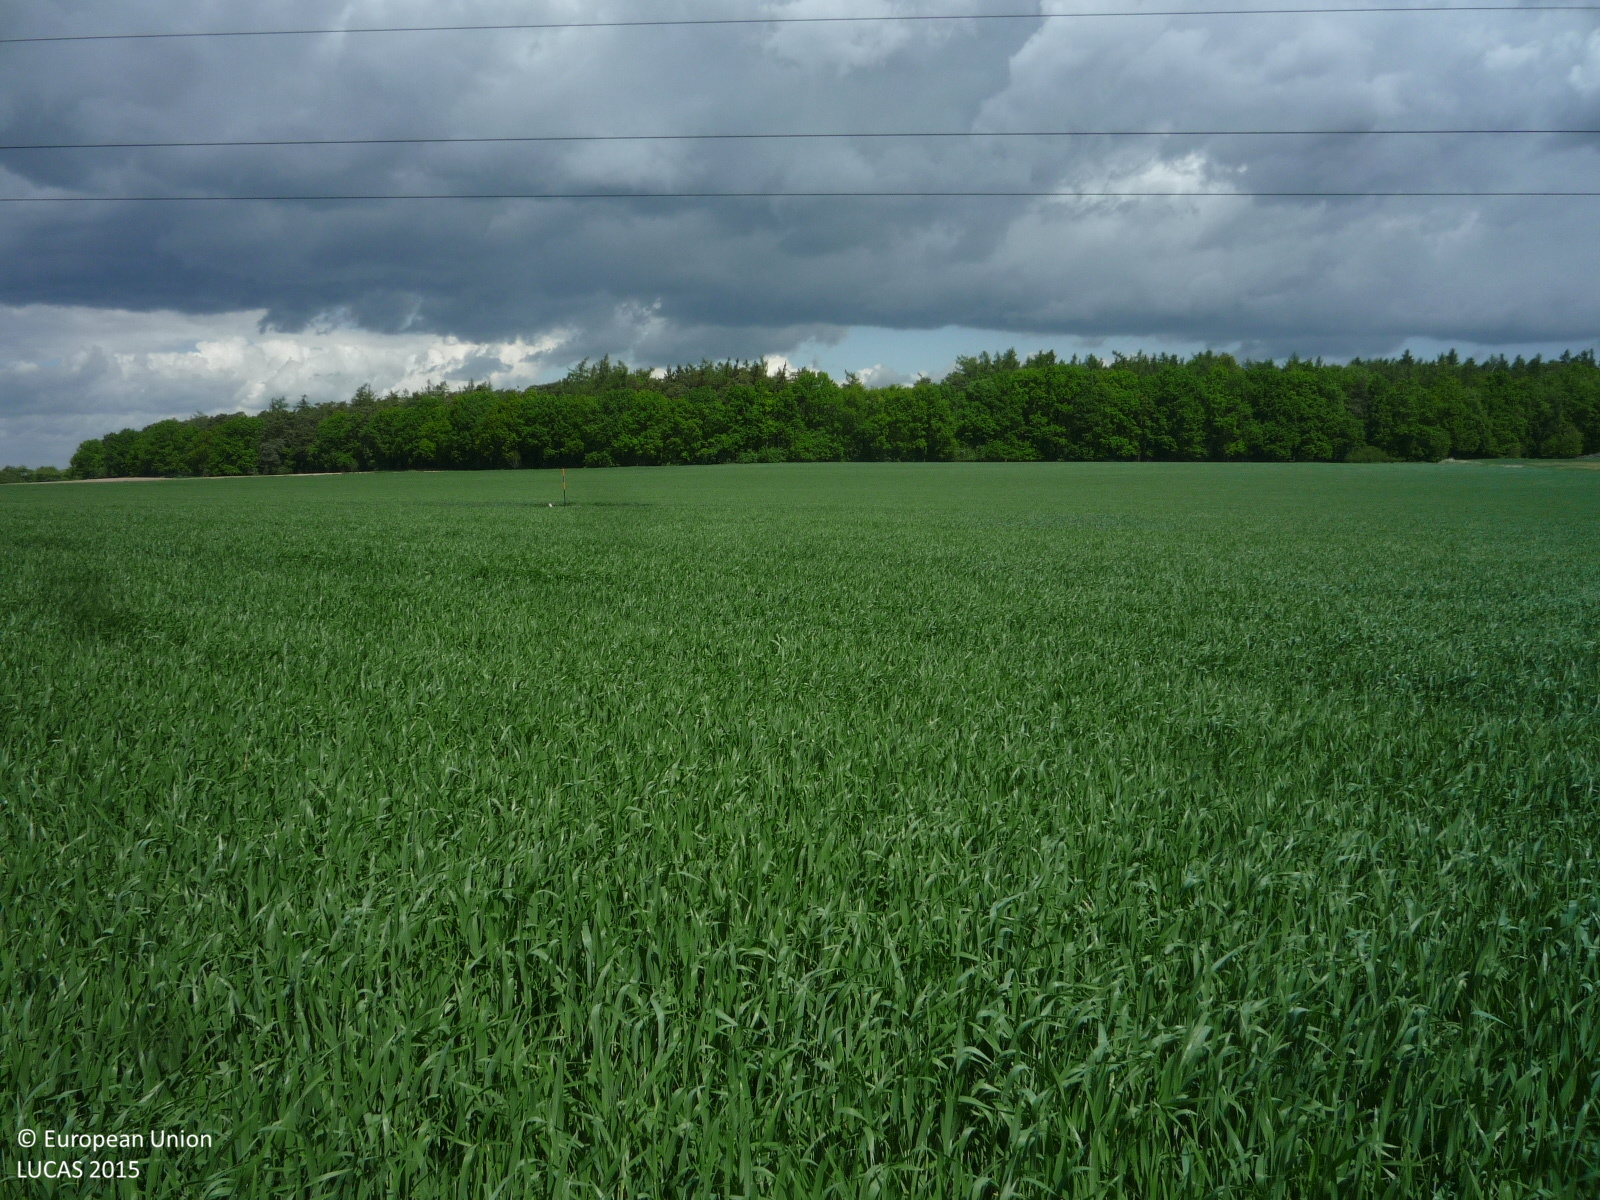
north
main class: Cropland
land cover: Barley
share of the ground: > 75 %
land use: Agriculture (excluding fallow land and kitchen gardens)
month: May
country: CZ
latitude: 50.1145
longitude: 14.9111
